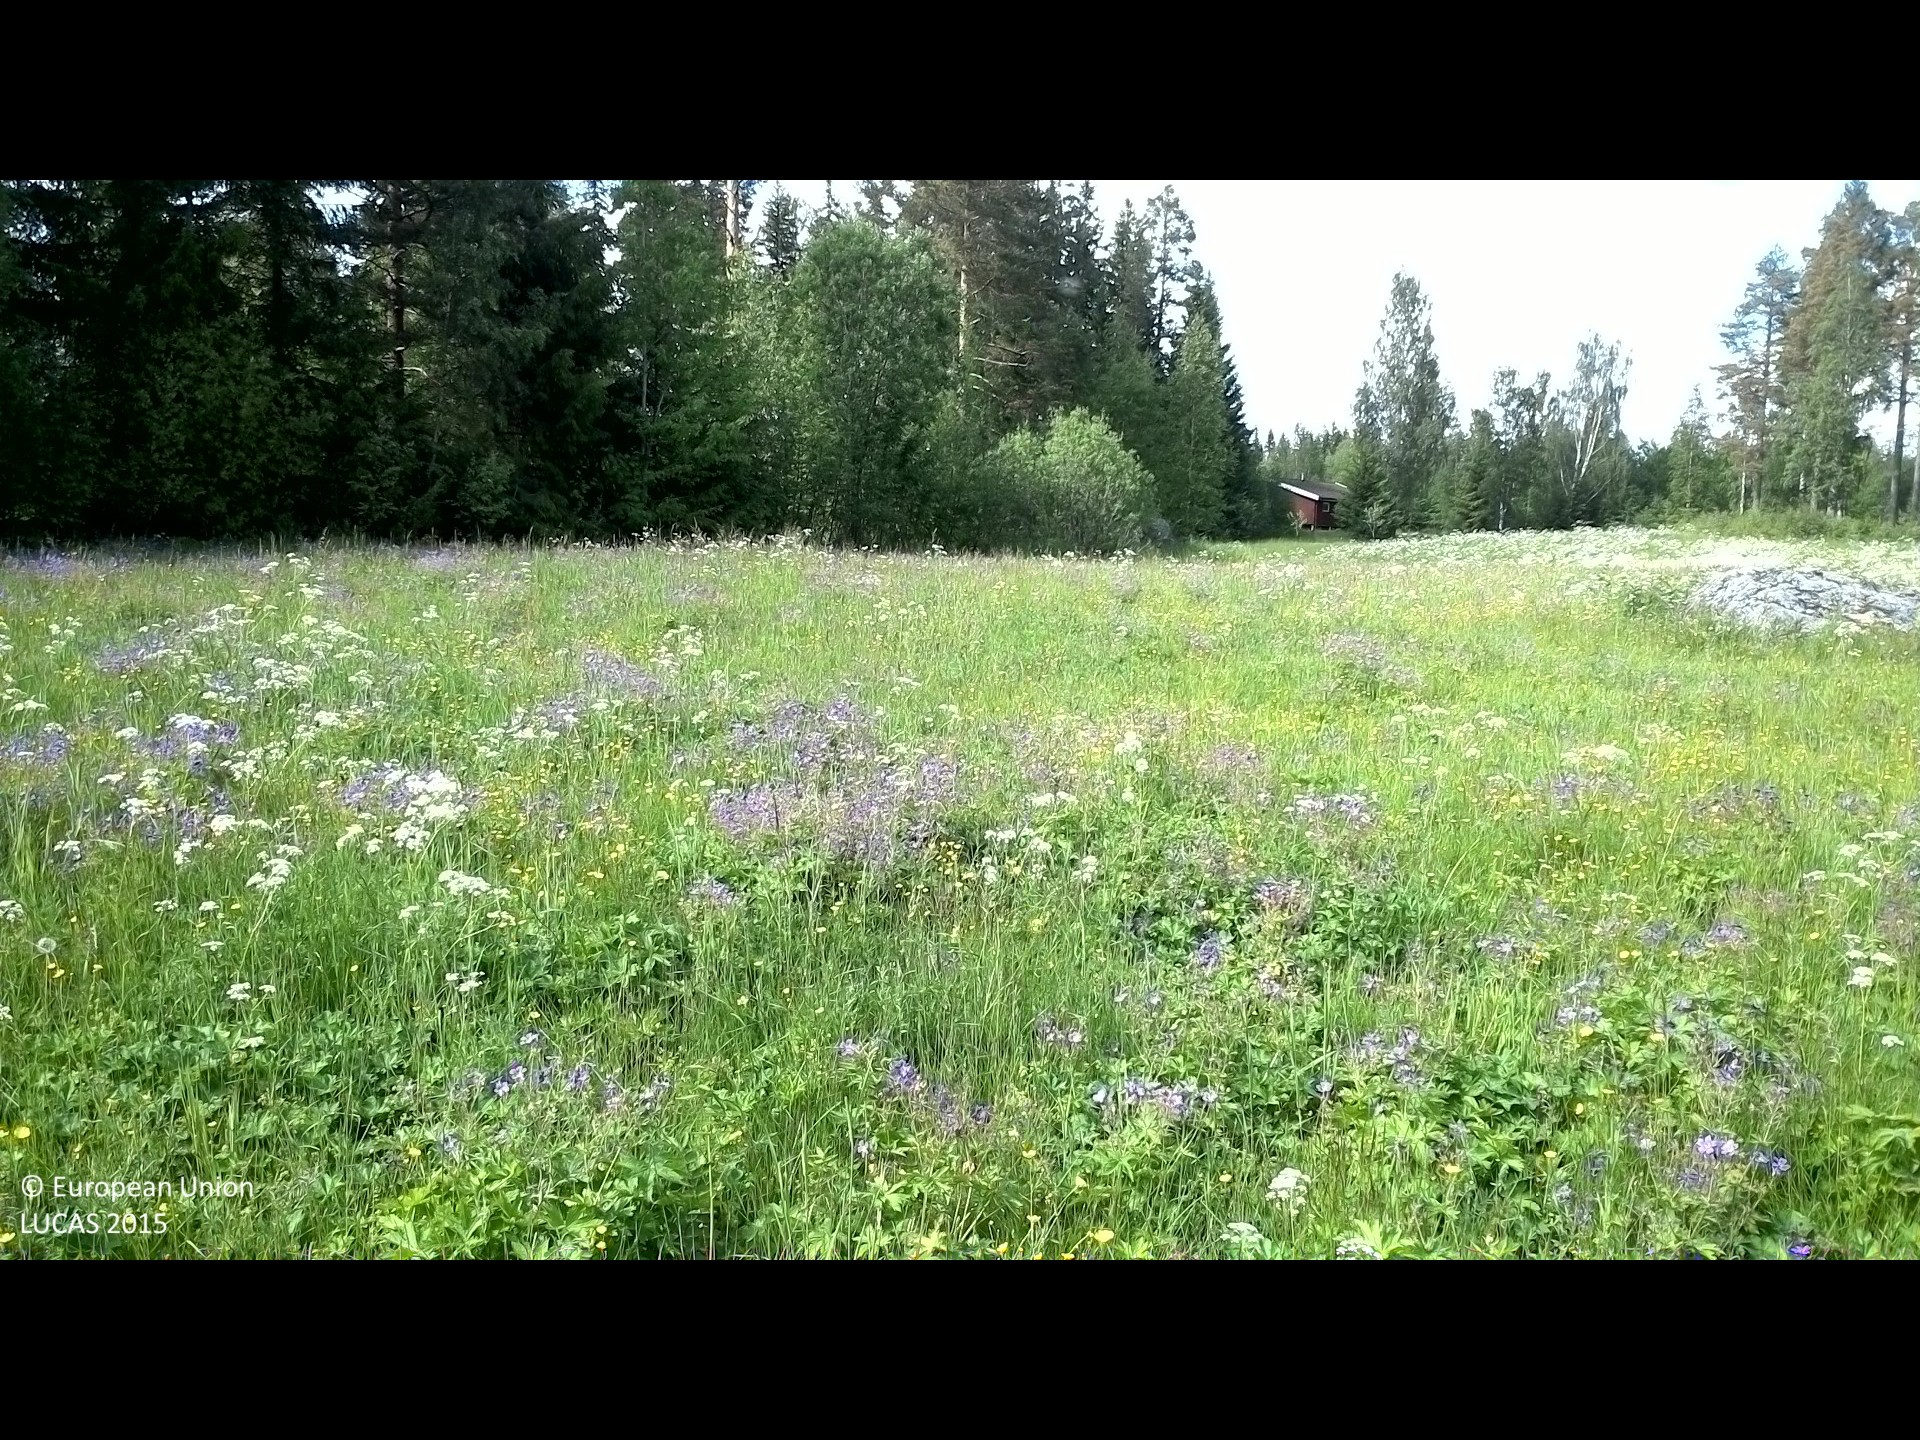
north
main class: Grassland
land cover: Grassland without tree/shrub cover
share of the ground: > 75 %
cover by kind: herbaceous plants 100 %
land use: Agriculture (excluding fallow land and kitchen gardens)
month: June
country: SE
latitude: 62.0600
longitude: 16.8116
